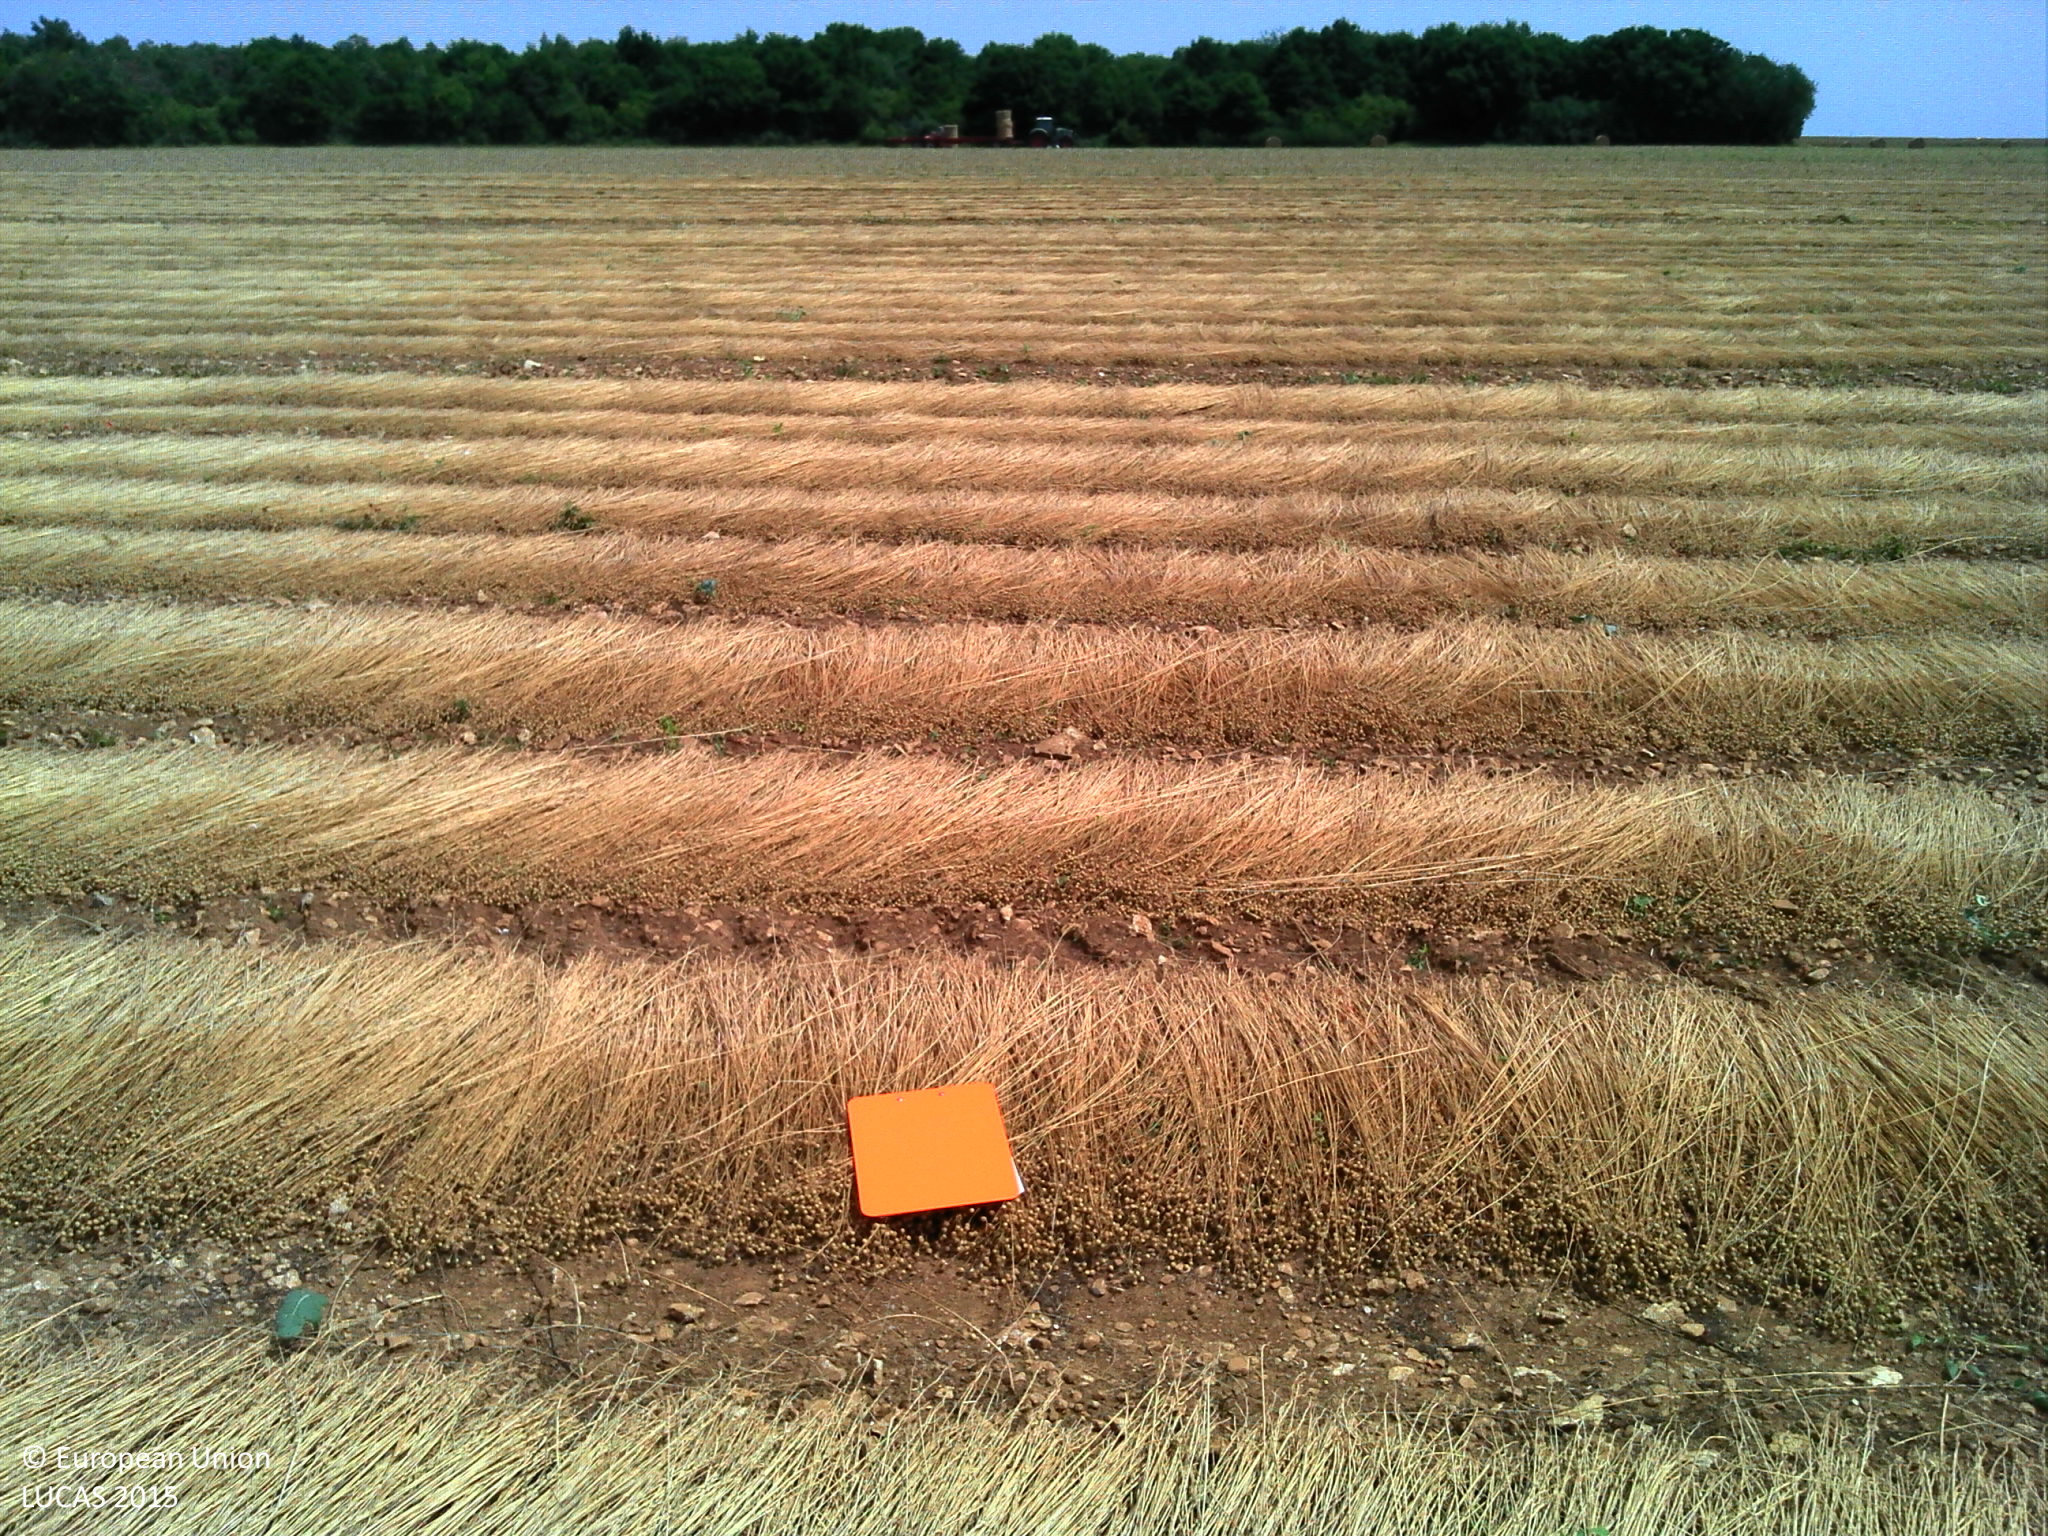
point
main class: Cropland
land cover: Other fibre and oleaginous crops
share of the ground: > 75 %
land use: Agriculture (excluding fallow land and kitchen gardens)
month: July
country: FR
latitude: 49.0370
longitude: -0.1963
